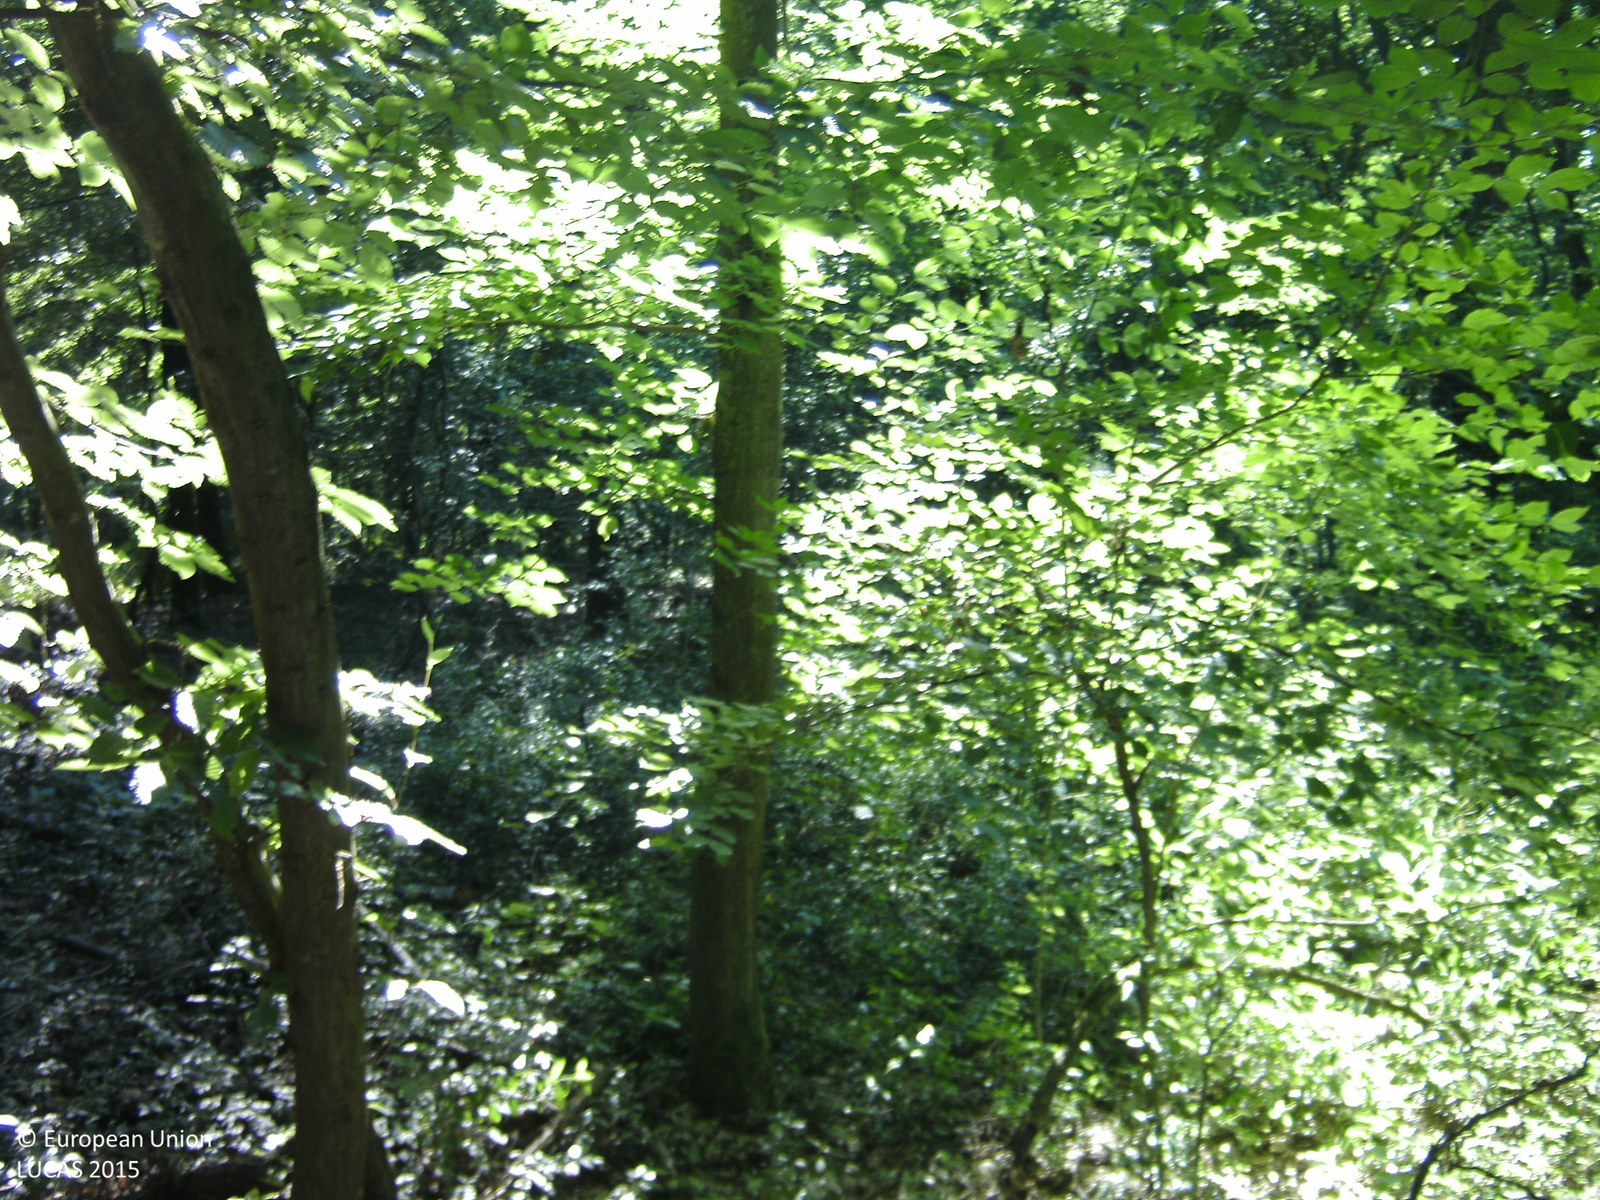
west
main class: Woodland
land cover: Broadleaved woodland
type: mesophytic deciduous forest
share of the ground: > 75 %
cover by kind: broadleaved forest trees 90 %, shrubs 5 %, herbaceous plants 5 %
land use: Forestry
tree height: > 5 m
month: June
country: HU
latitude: 46.4420
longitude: 17.8554
